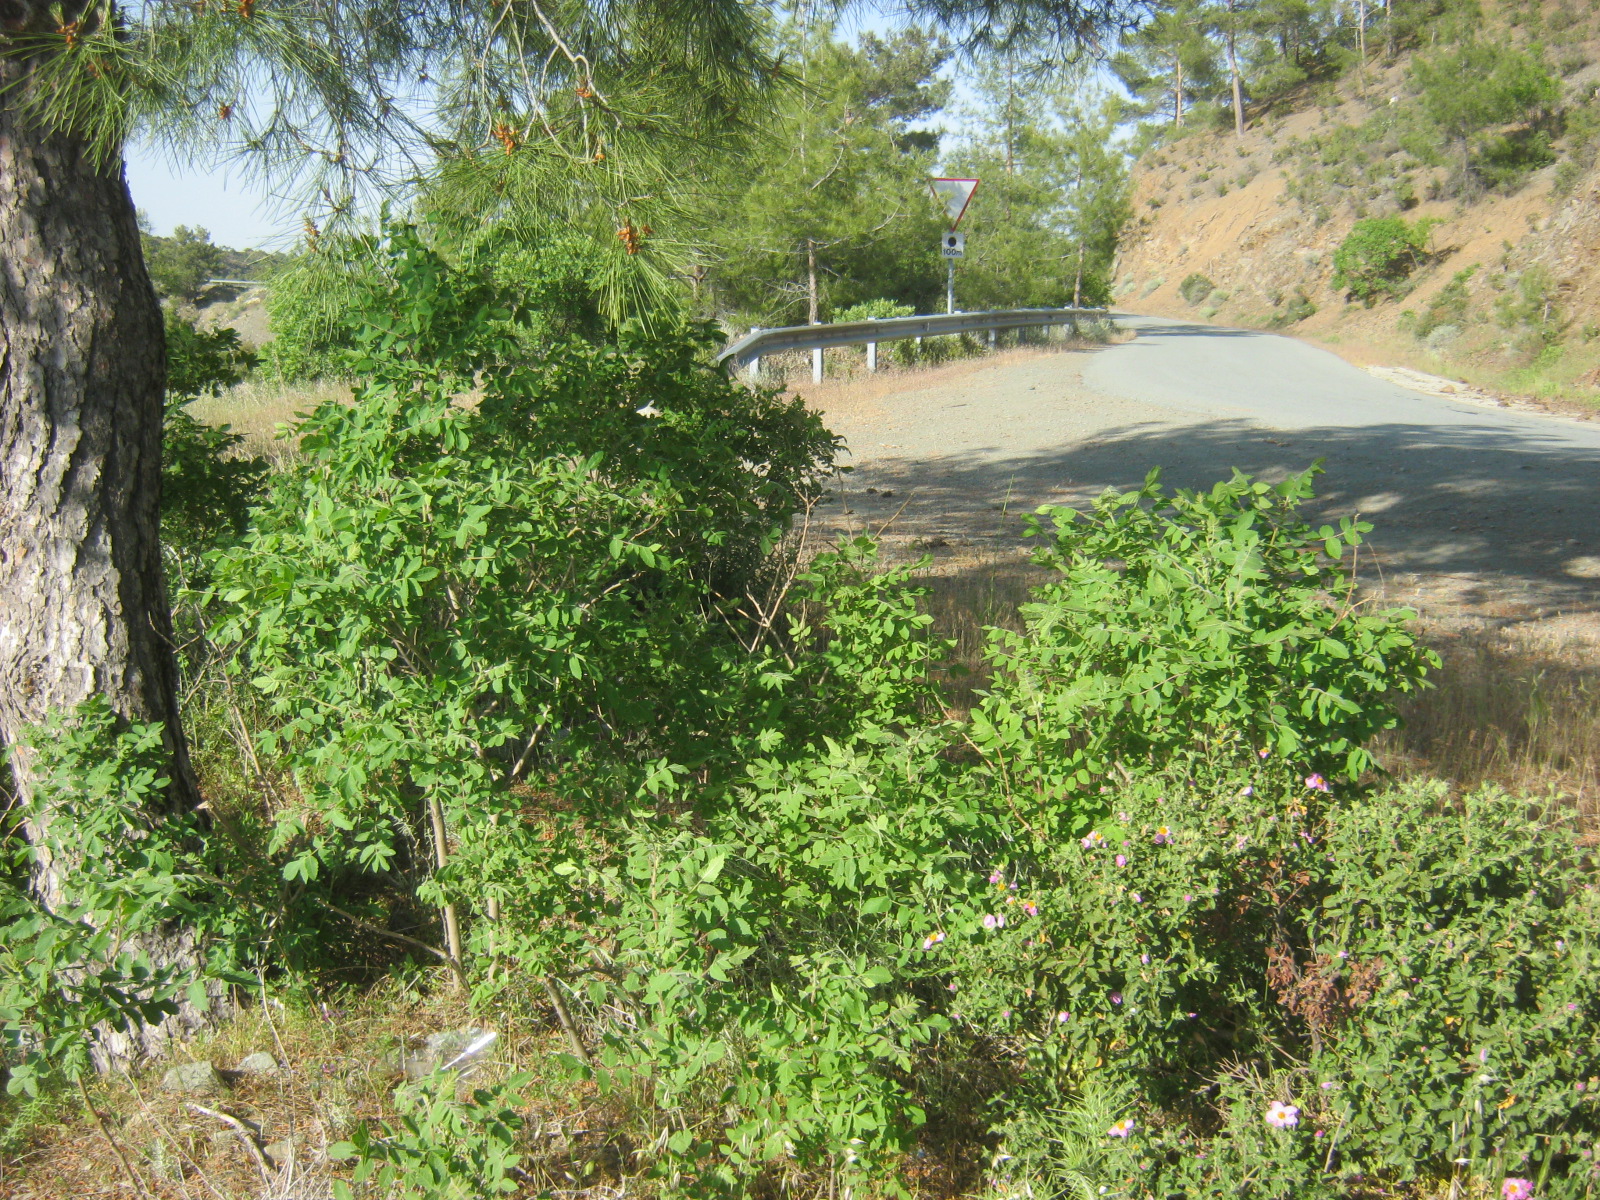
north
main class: Woodland
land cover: Pine dominated coniferous woodland
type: coniferous forest of the mediterranean region
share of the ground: > 75 %
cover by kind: coniferous forest trees 80 %, broadleaved forest trees 10 %, shrubs 10 %
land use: Semi-natural and natural areas not in use
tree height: > 5 m
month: May
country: CY
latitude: 34.9745
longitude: 32.8061
